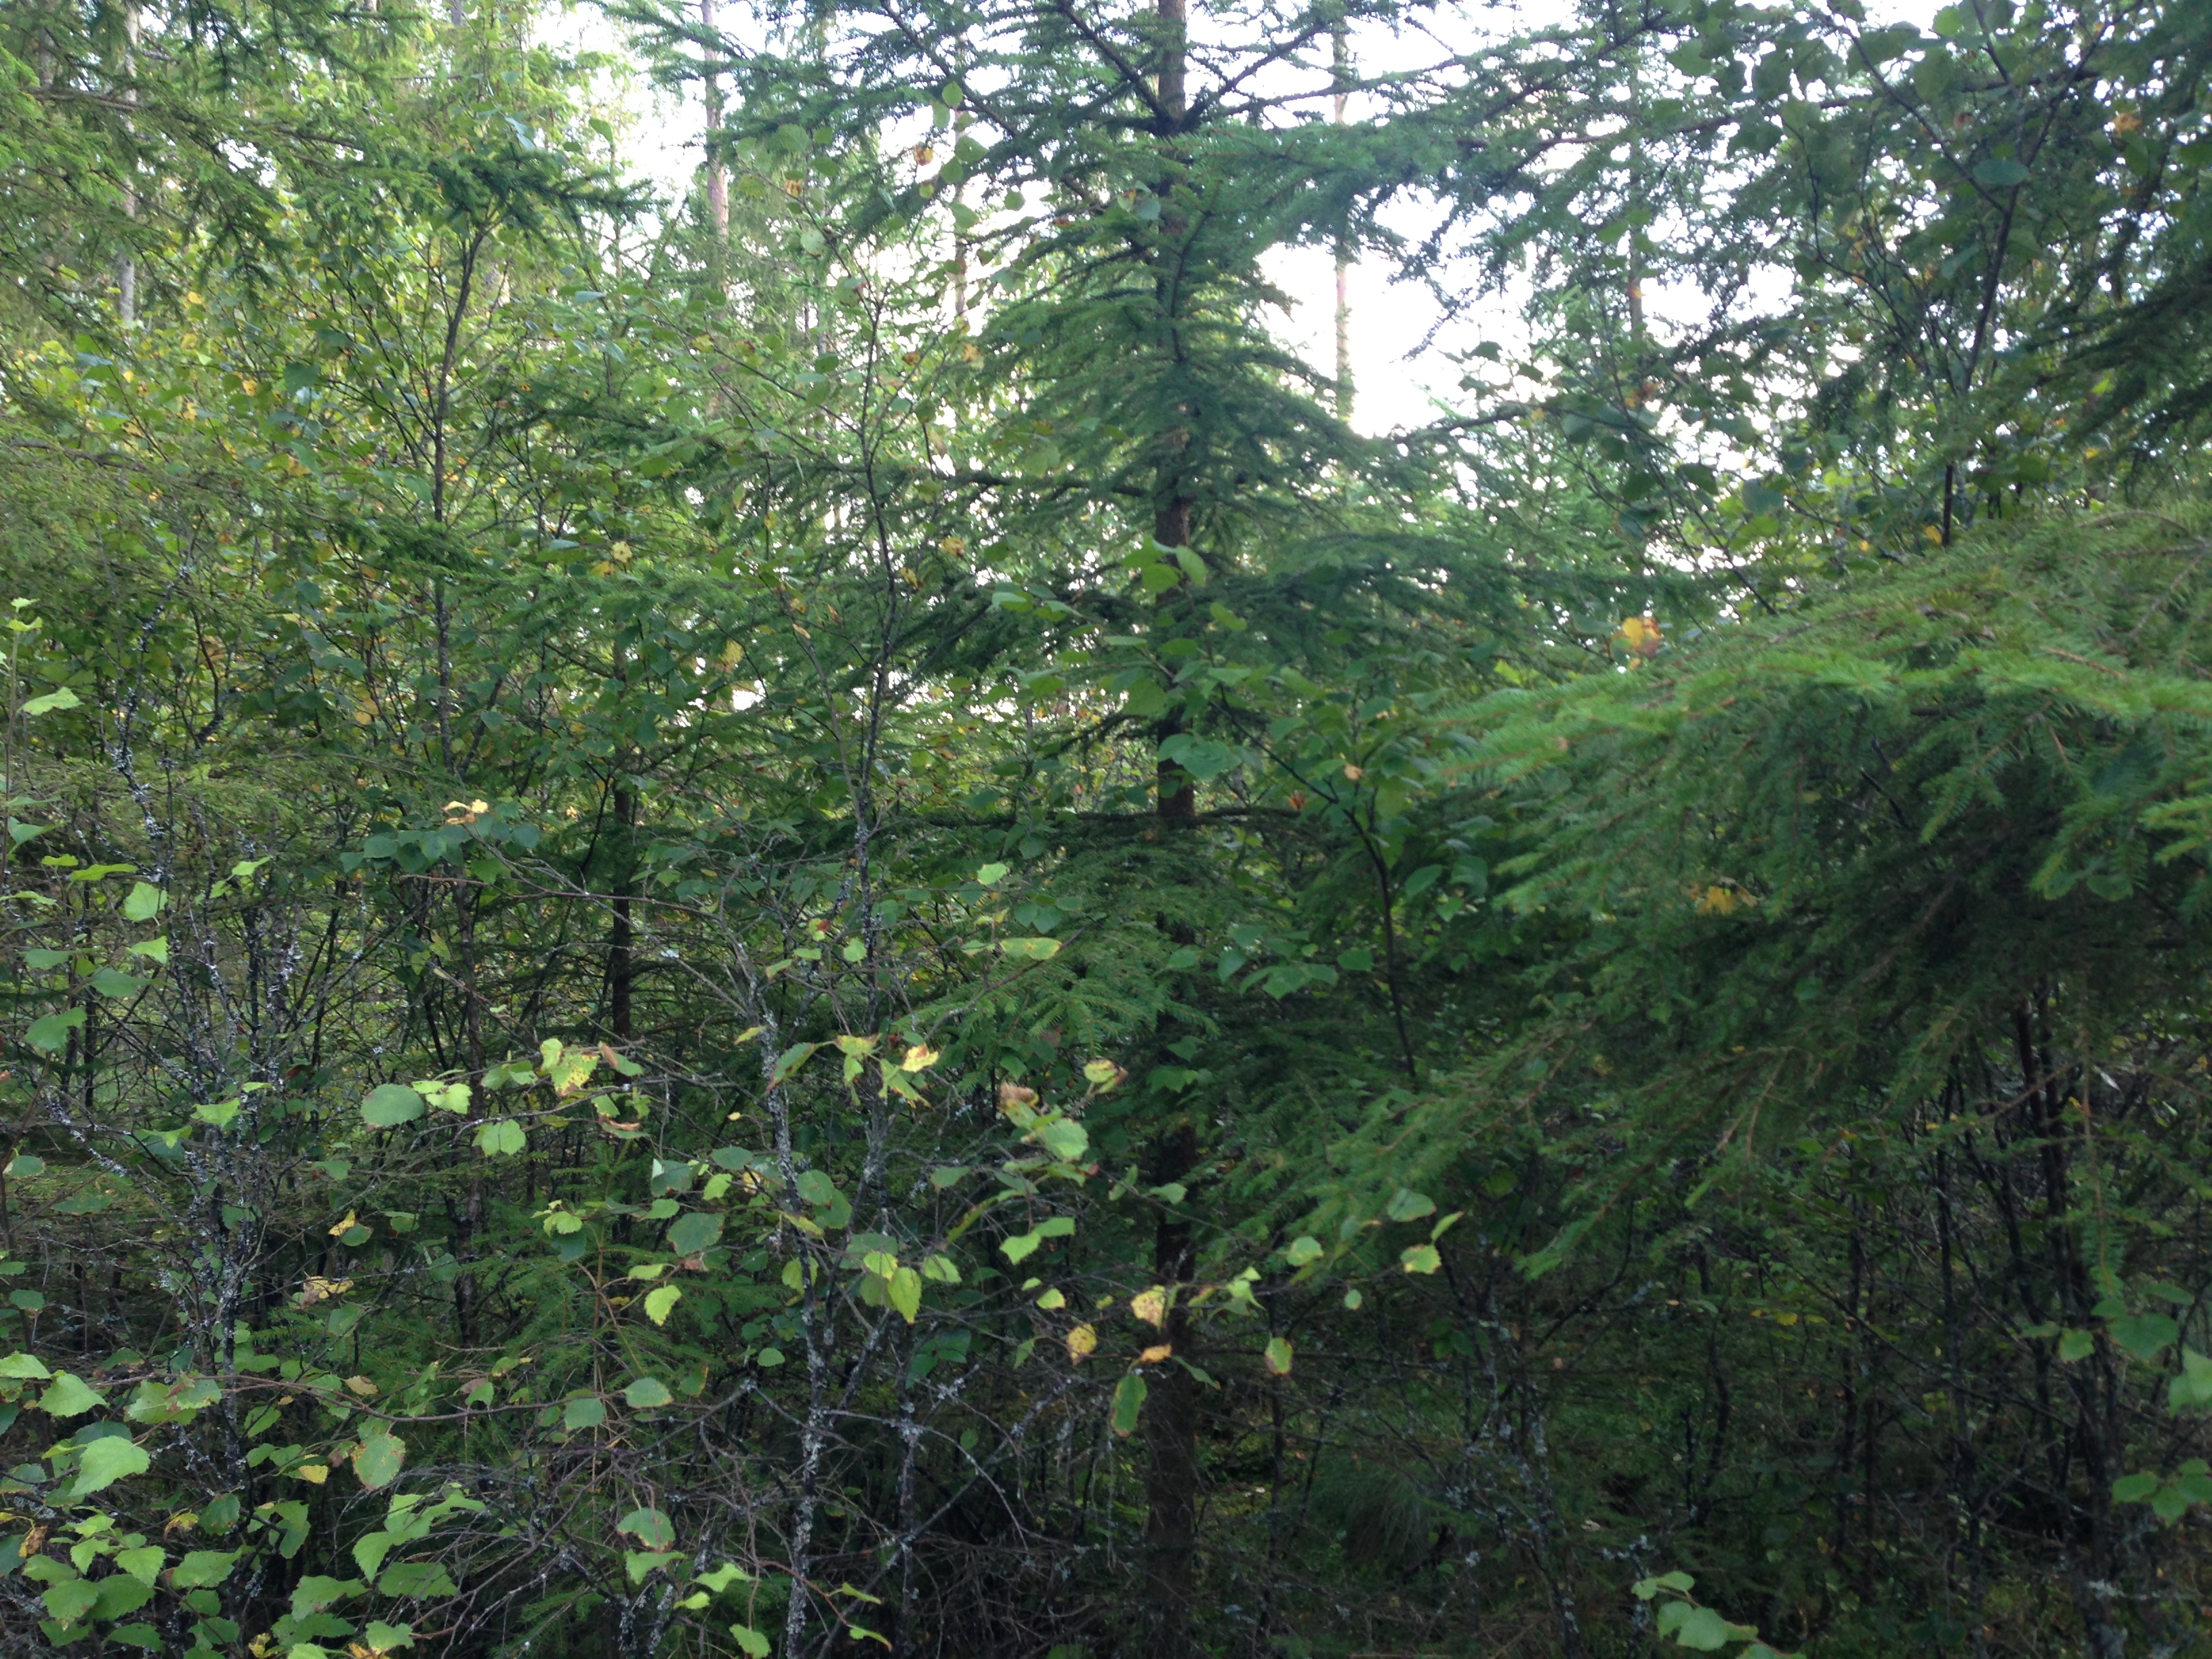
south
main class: Woodland
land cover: Spruce dominated mixed woodland
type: boreal forest
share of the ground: > 75 %
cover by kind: coniferous forest trees 60 %, broadleaved forest trees 20 %, shrubs 20 %
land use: Forestry
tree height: > 5 m
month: September
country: SE
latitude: 57.1207
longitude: 13.1508
